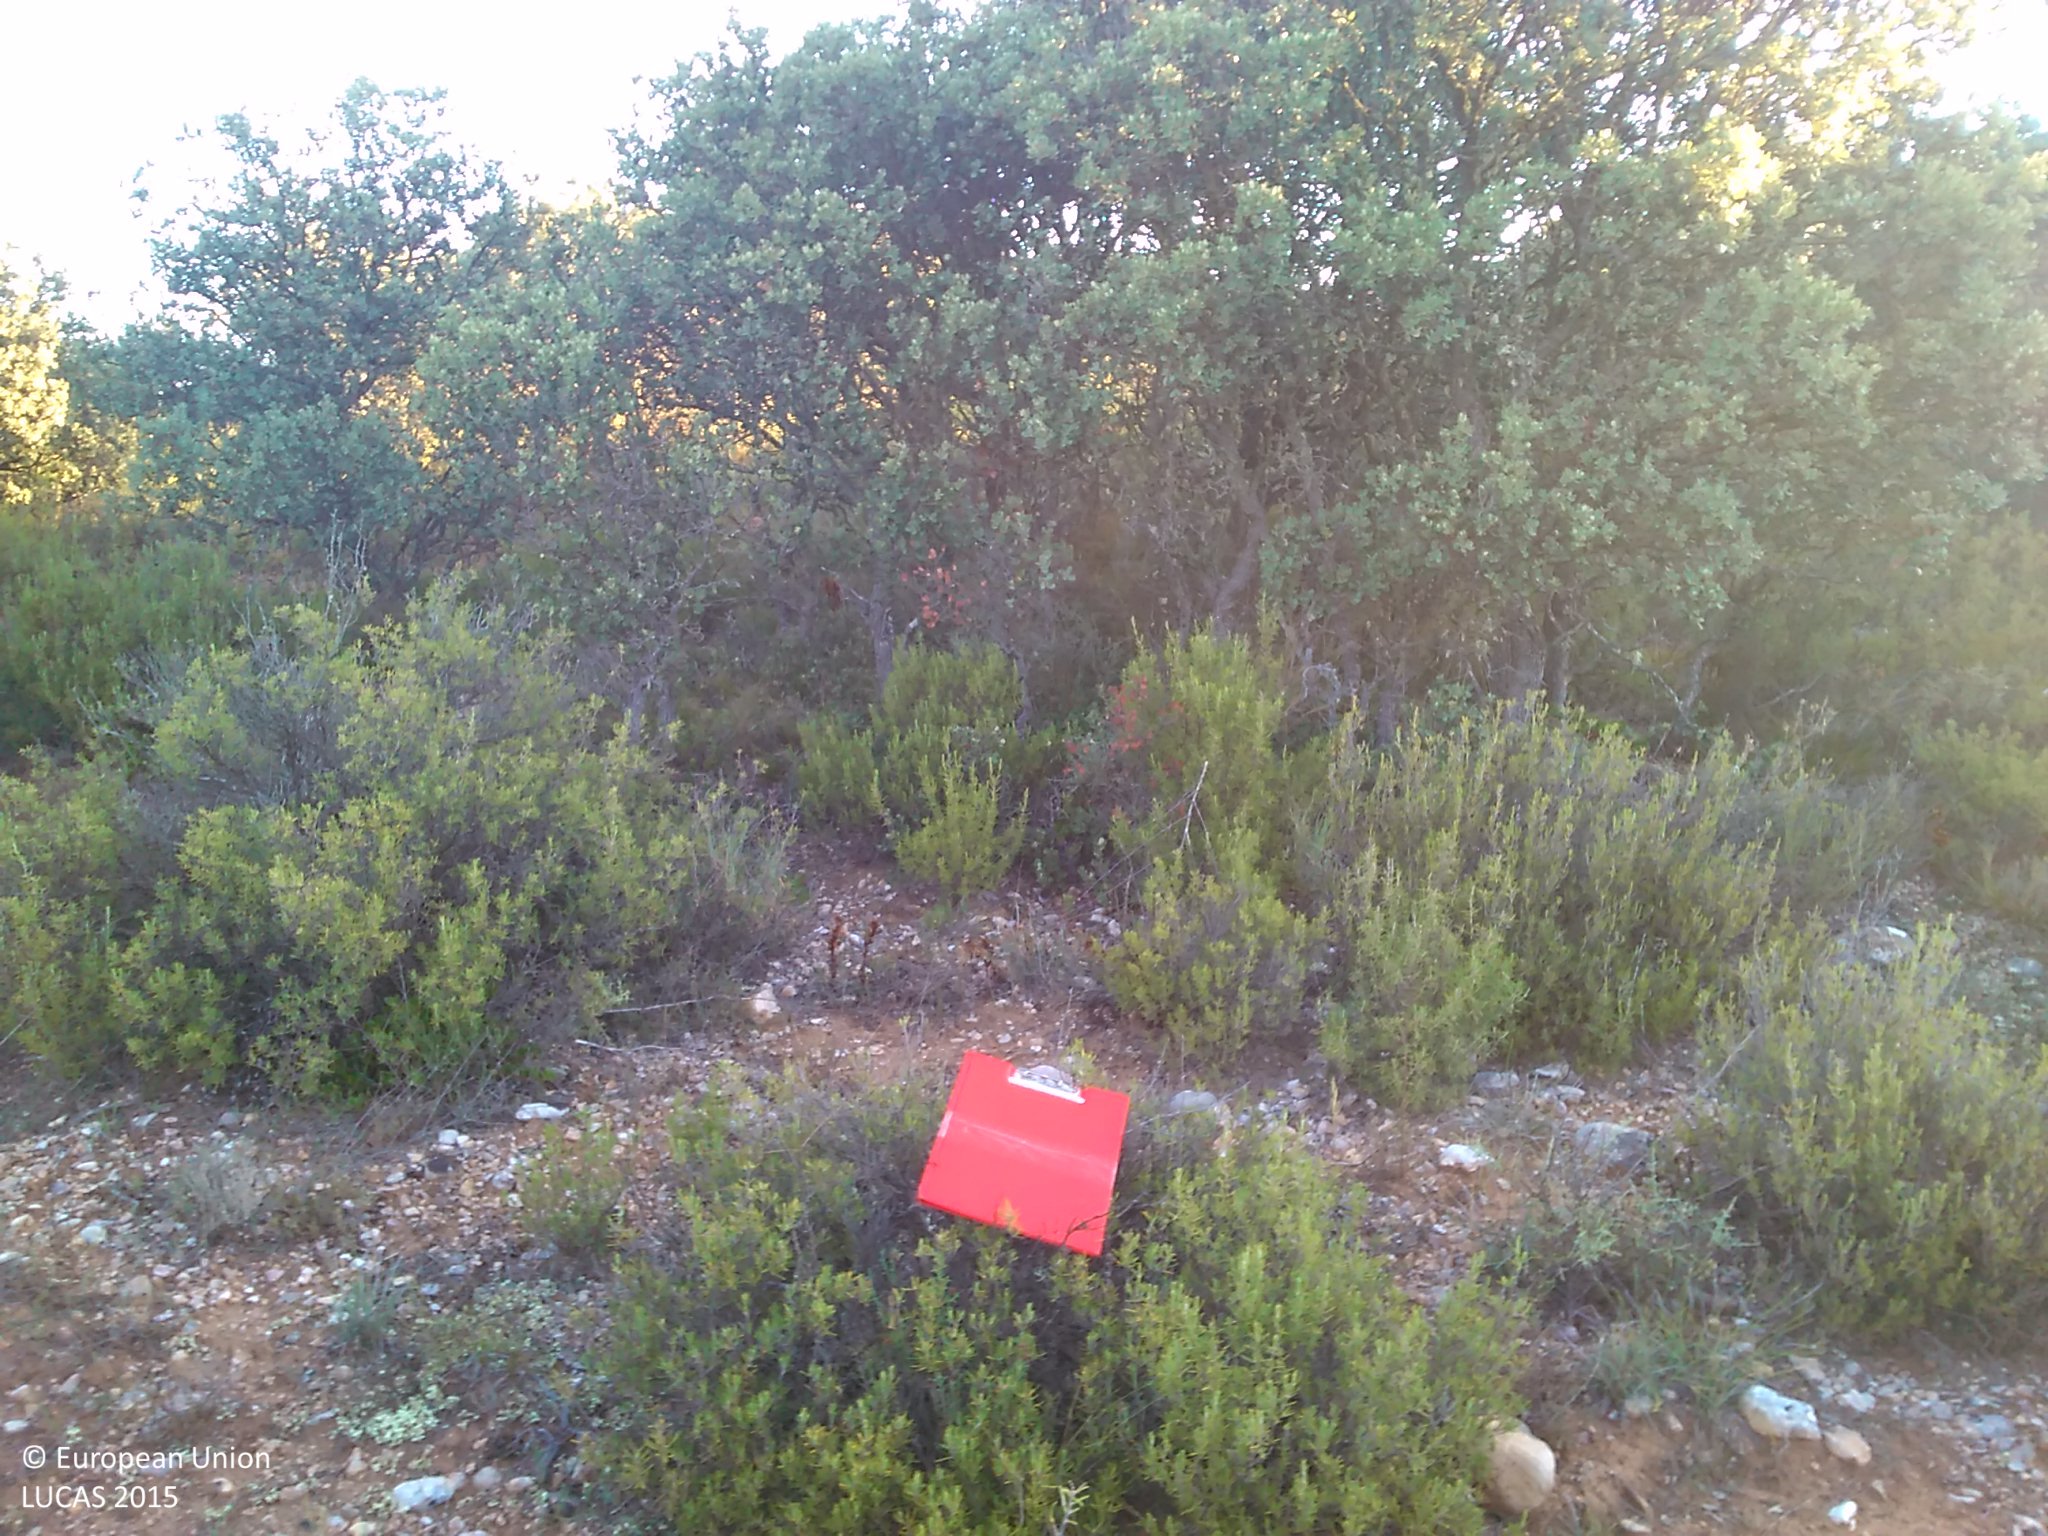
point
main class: Woodland
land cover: Broadleaved woodland
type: broadleaved evergreen forest
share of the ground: 50 - 75 %
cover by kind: broadleaved forest trees 50 %, shrubs 30 %, unconsolidated bare surface 15 %, herbaceous plants 5 %
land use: Semi-natural and natural areas not in use
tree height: < 5 m
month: July
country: ES
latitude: 41.4859
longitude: -2.1159
